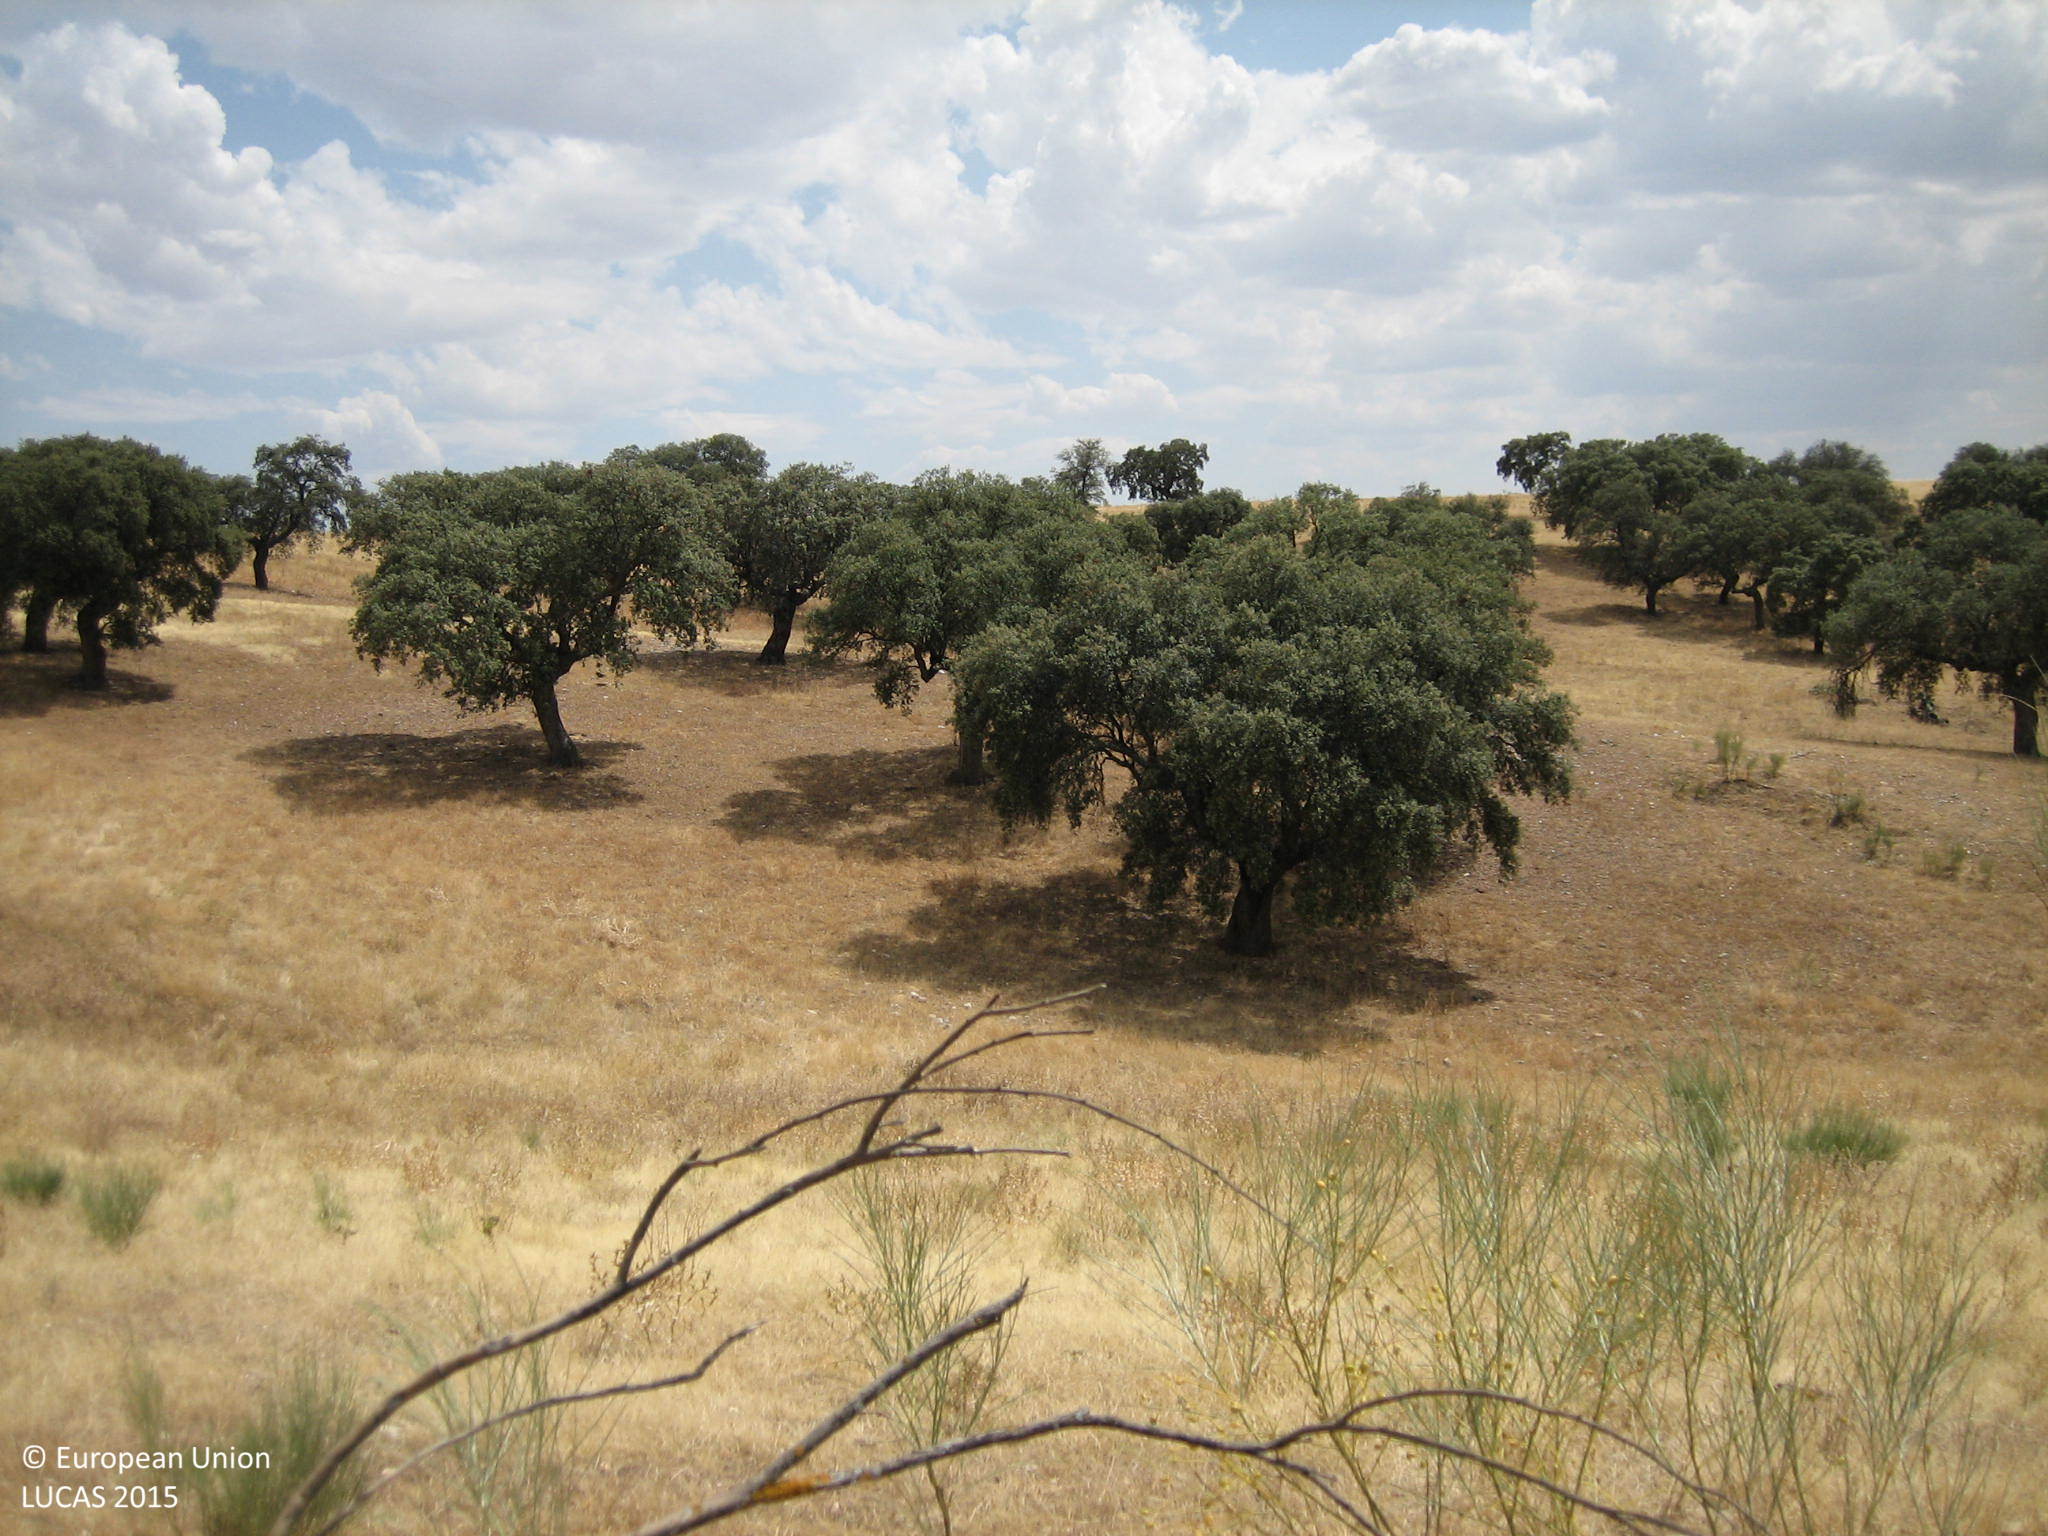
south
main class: Shrubland
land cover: Shrubland with sparse tree cover
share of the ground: 50 - 75 %
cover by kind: herbaceous plants 50 %, shrubs 45 %, broadleaved forest trees 5 %
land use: Agriculture (excluding fallow land and kitchen gardens)
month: July
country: ES
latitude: 38.5507
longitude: -5.3756
